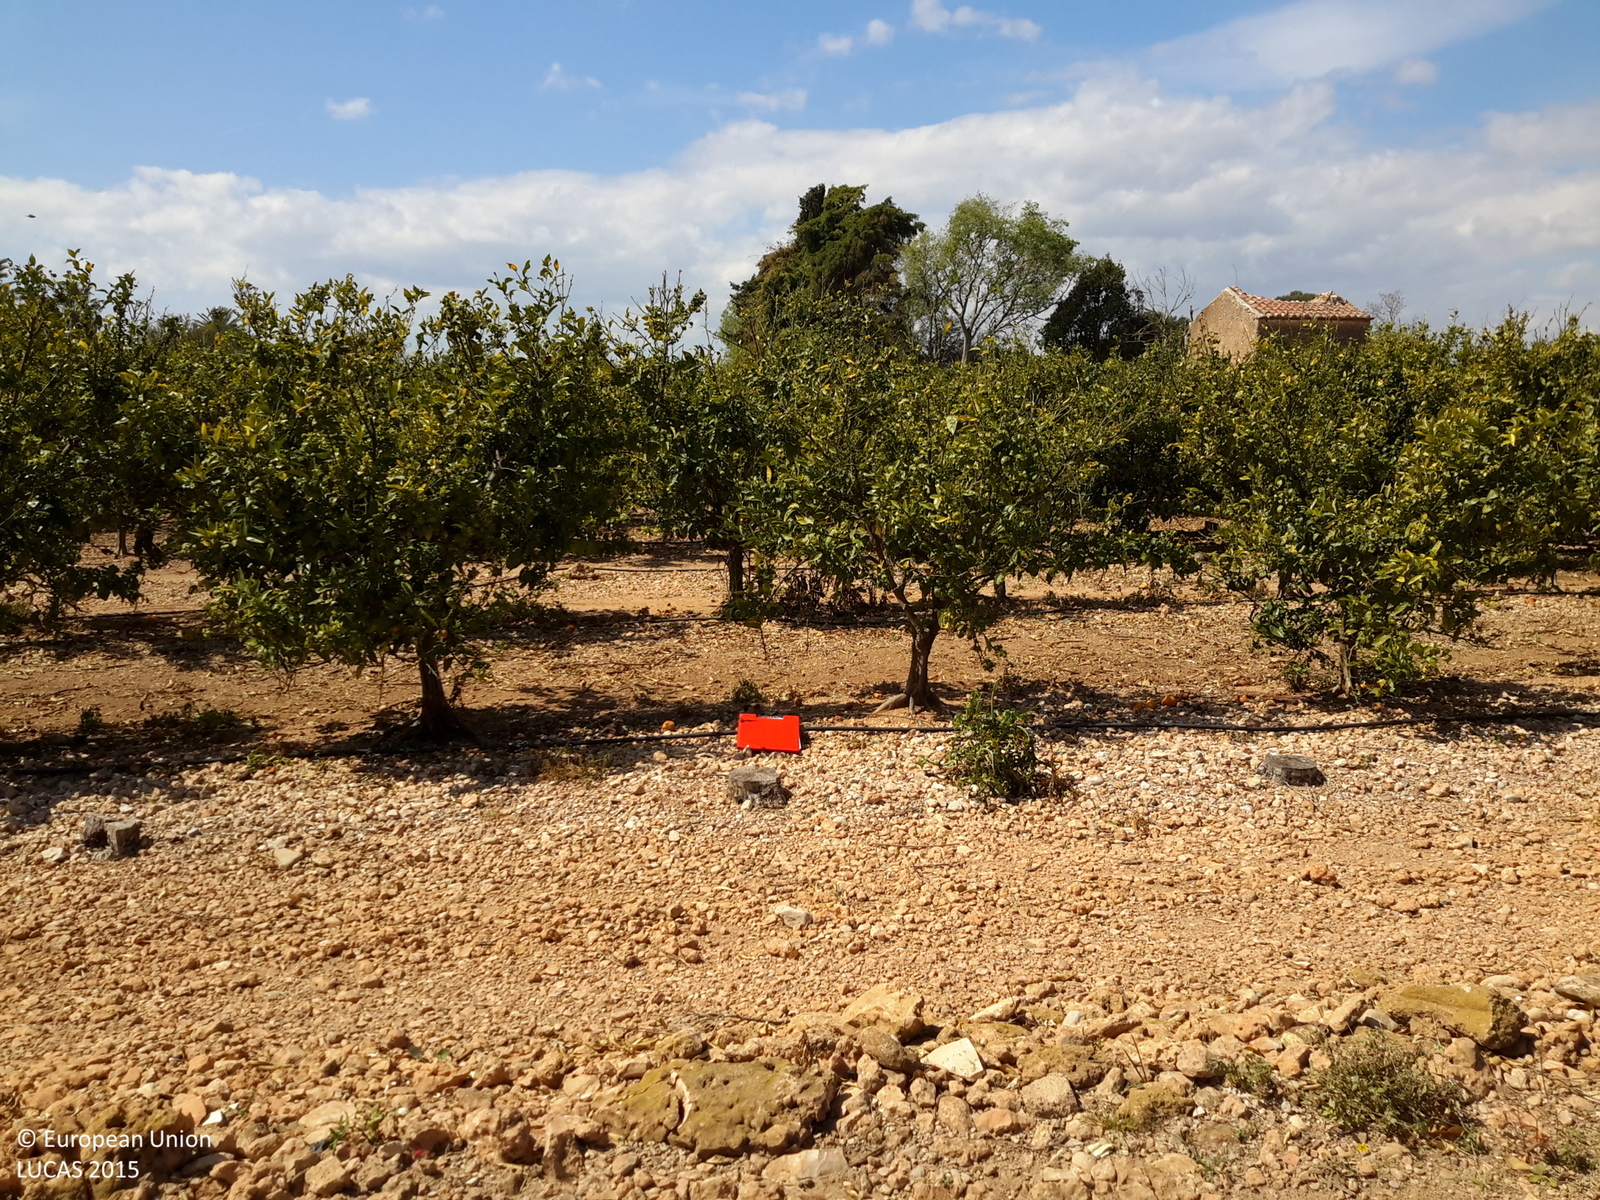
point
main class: Cropland
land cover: Oranges
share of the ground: 50 - 75 %
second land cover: Other bare soil
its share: > 75 %
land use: Agriculture (excluding fallow land and kitchen gardens)
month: April
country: ES
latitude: 40.5351
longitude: 0.5161
